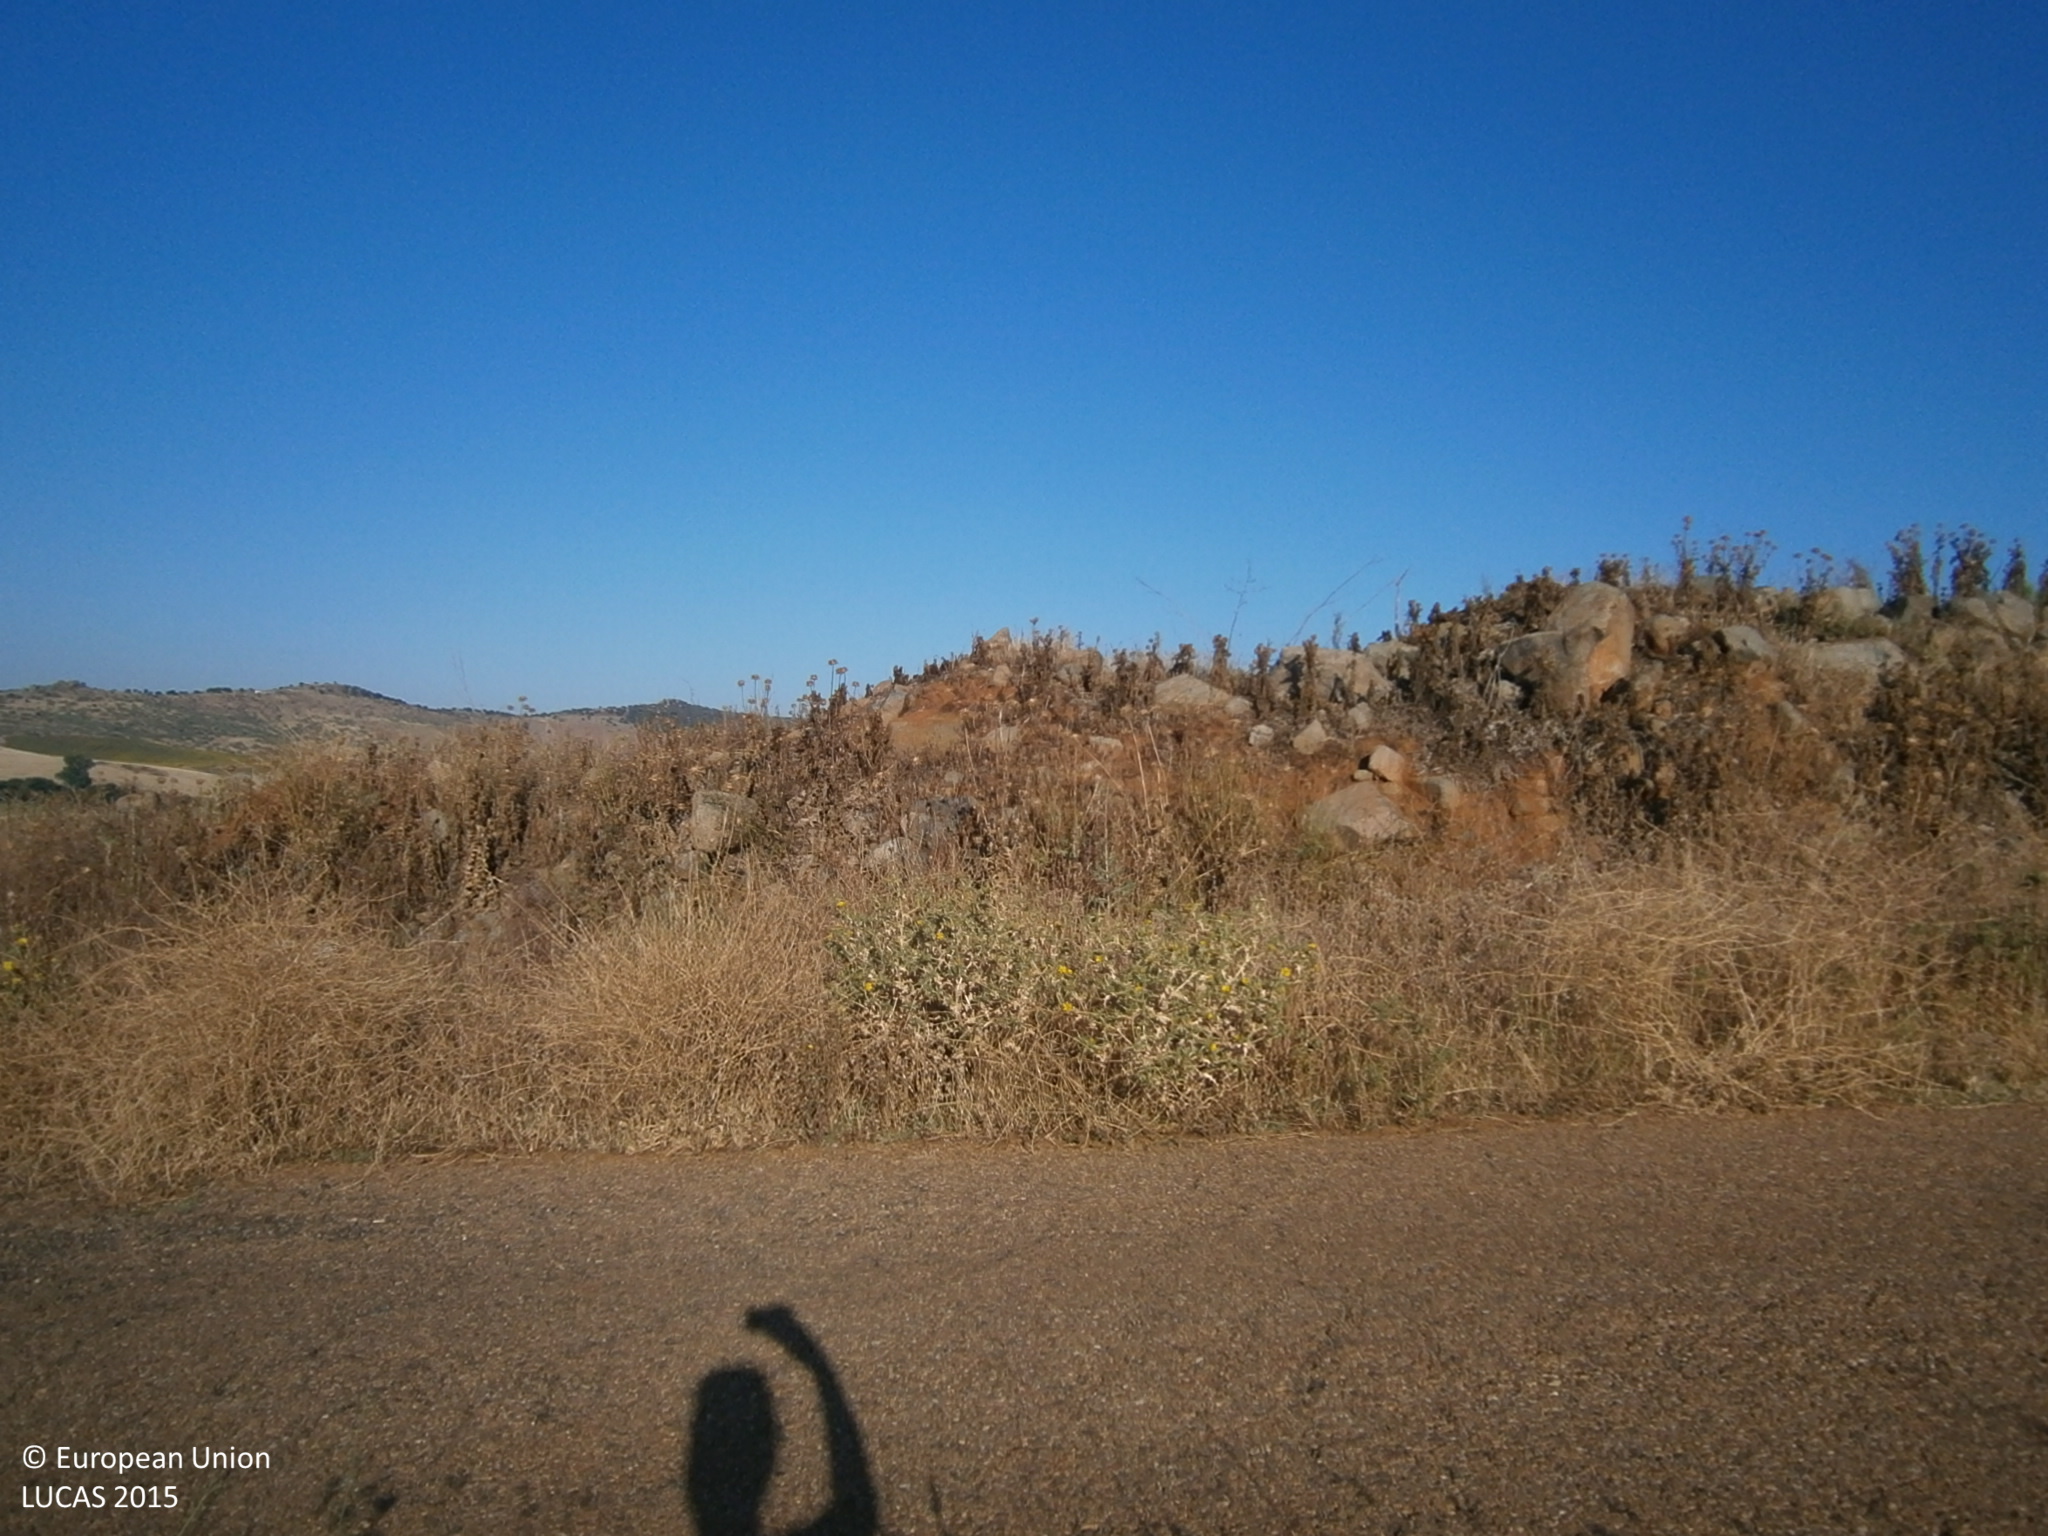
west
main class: Cropland
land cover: Maize
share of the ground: > 75 %
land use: Agriculture (excluding fallow land and kitchen gardens)
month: June
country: ES
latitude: 38.8268
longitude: -6.2613
